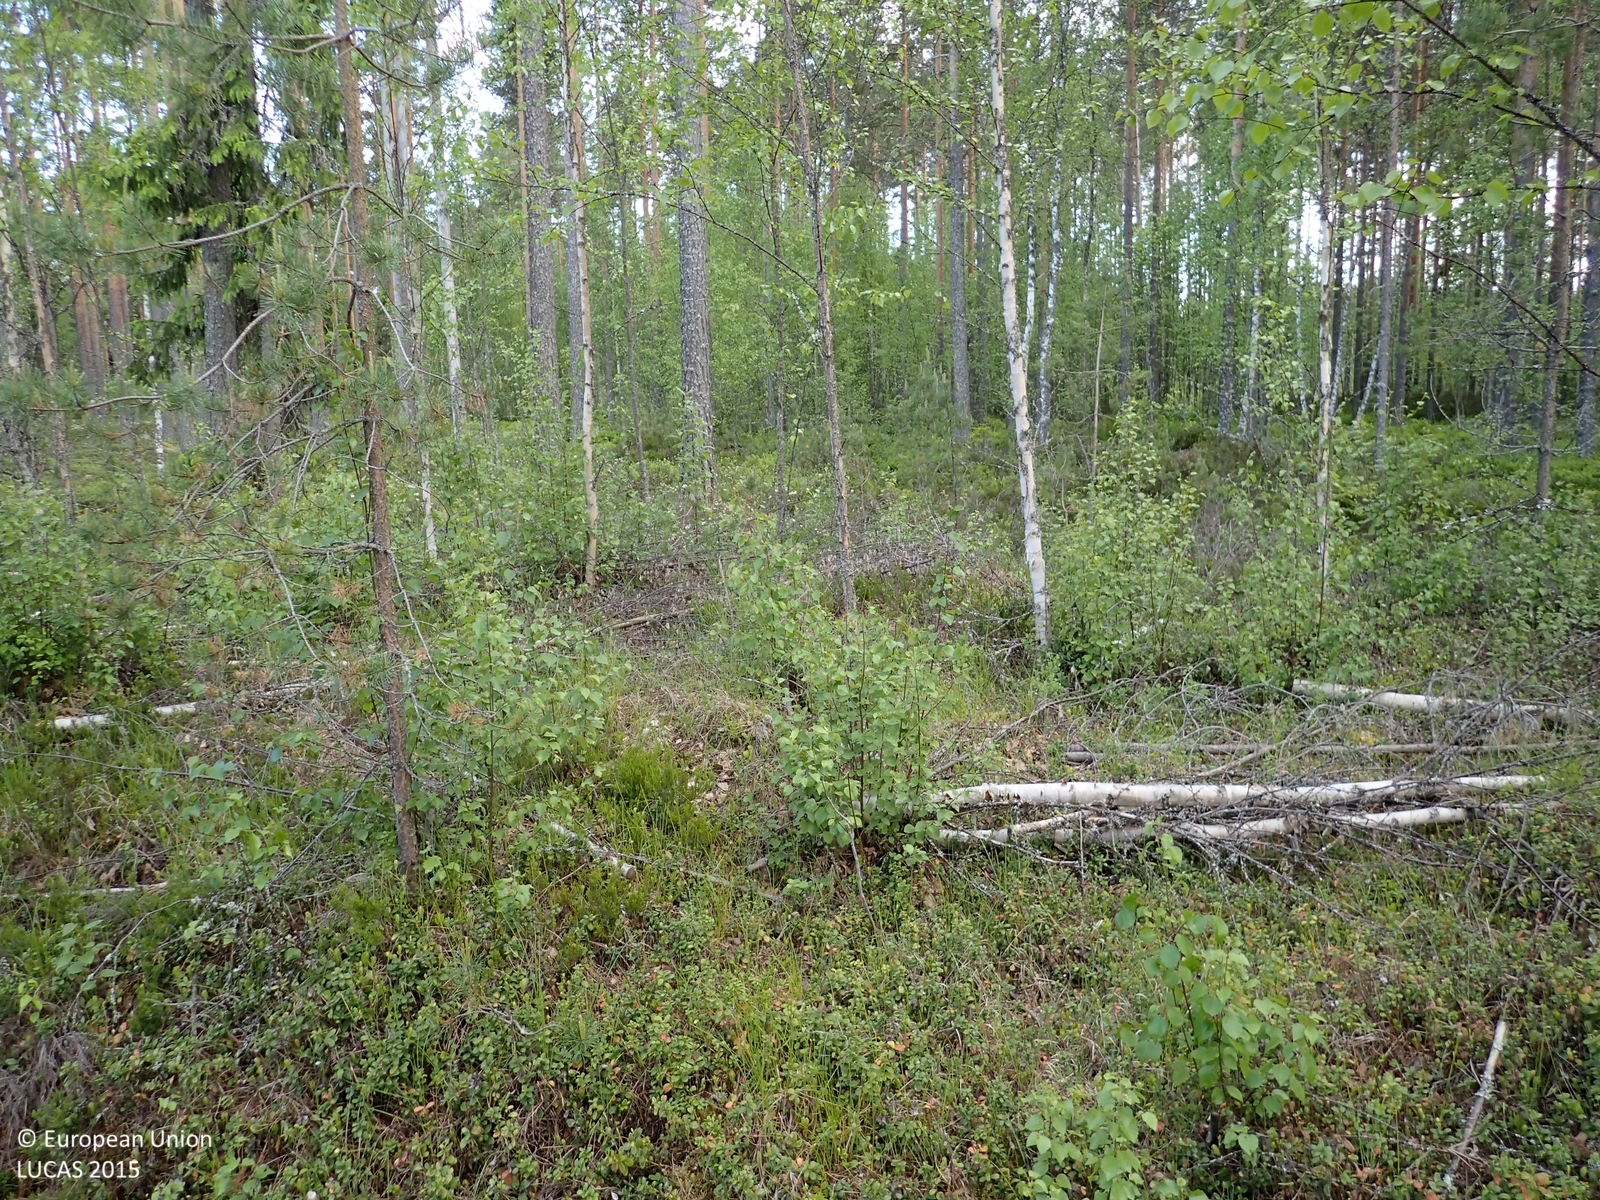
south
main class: Woodland
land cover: Pine dominated mixed woodland
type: boreal forest
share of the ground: 50 - 75 %
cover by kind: shrubs 50 %, coniferous forest trees 35 %, broadleaved forest trees 15 %
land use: Forestry
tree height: < 5 m
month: June
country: FI
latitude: 62.5104
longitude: 23.1342
